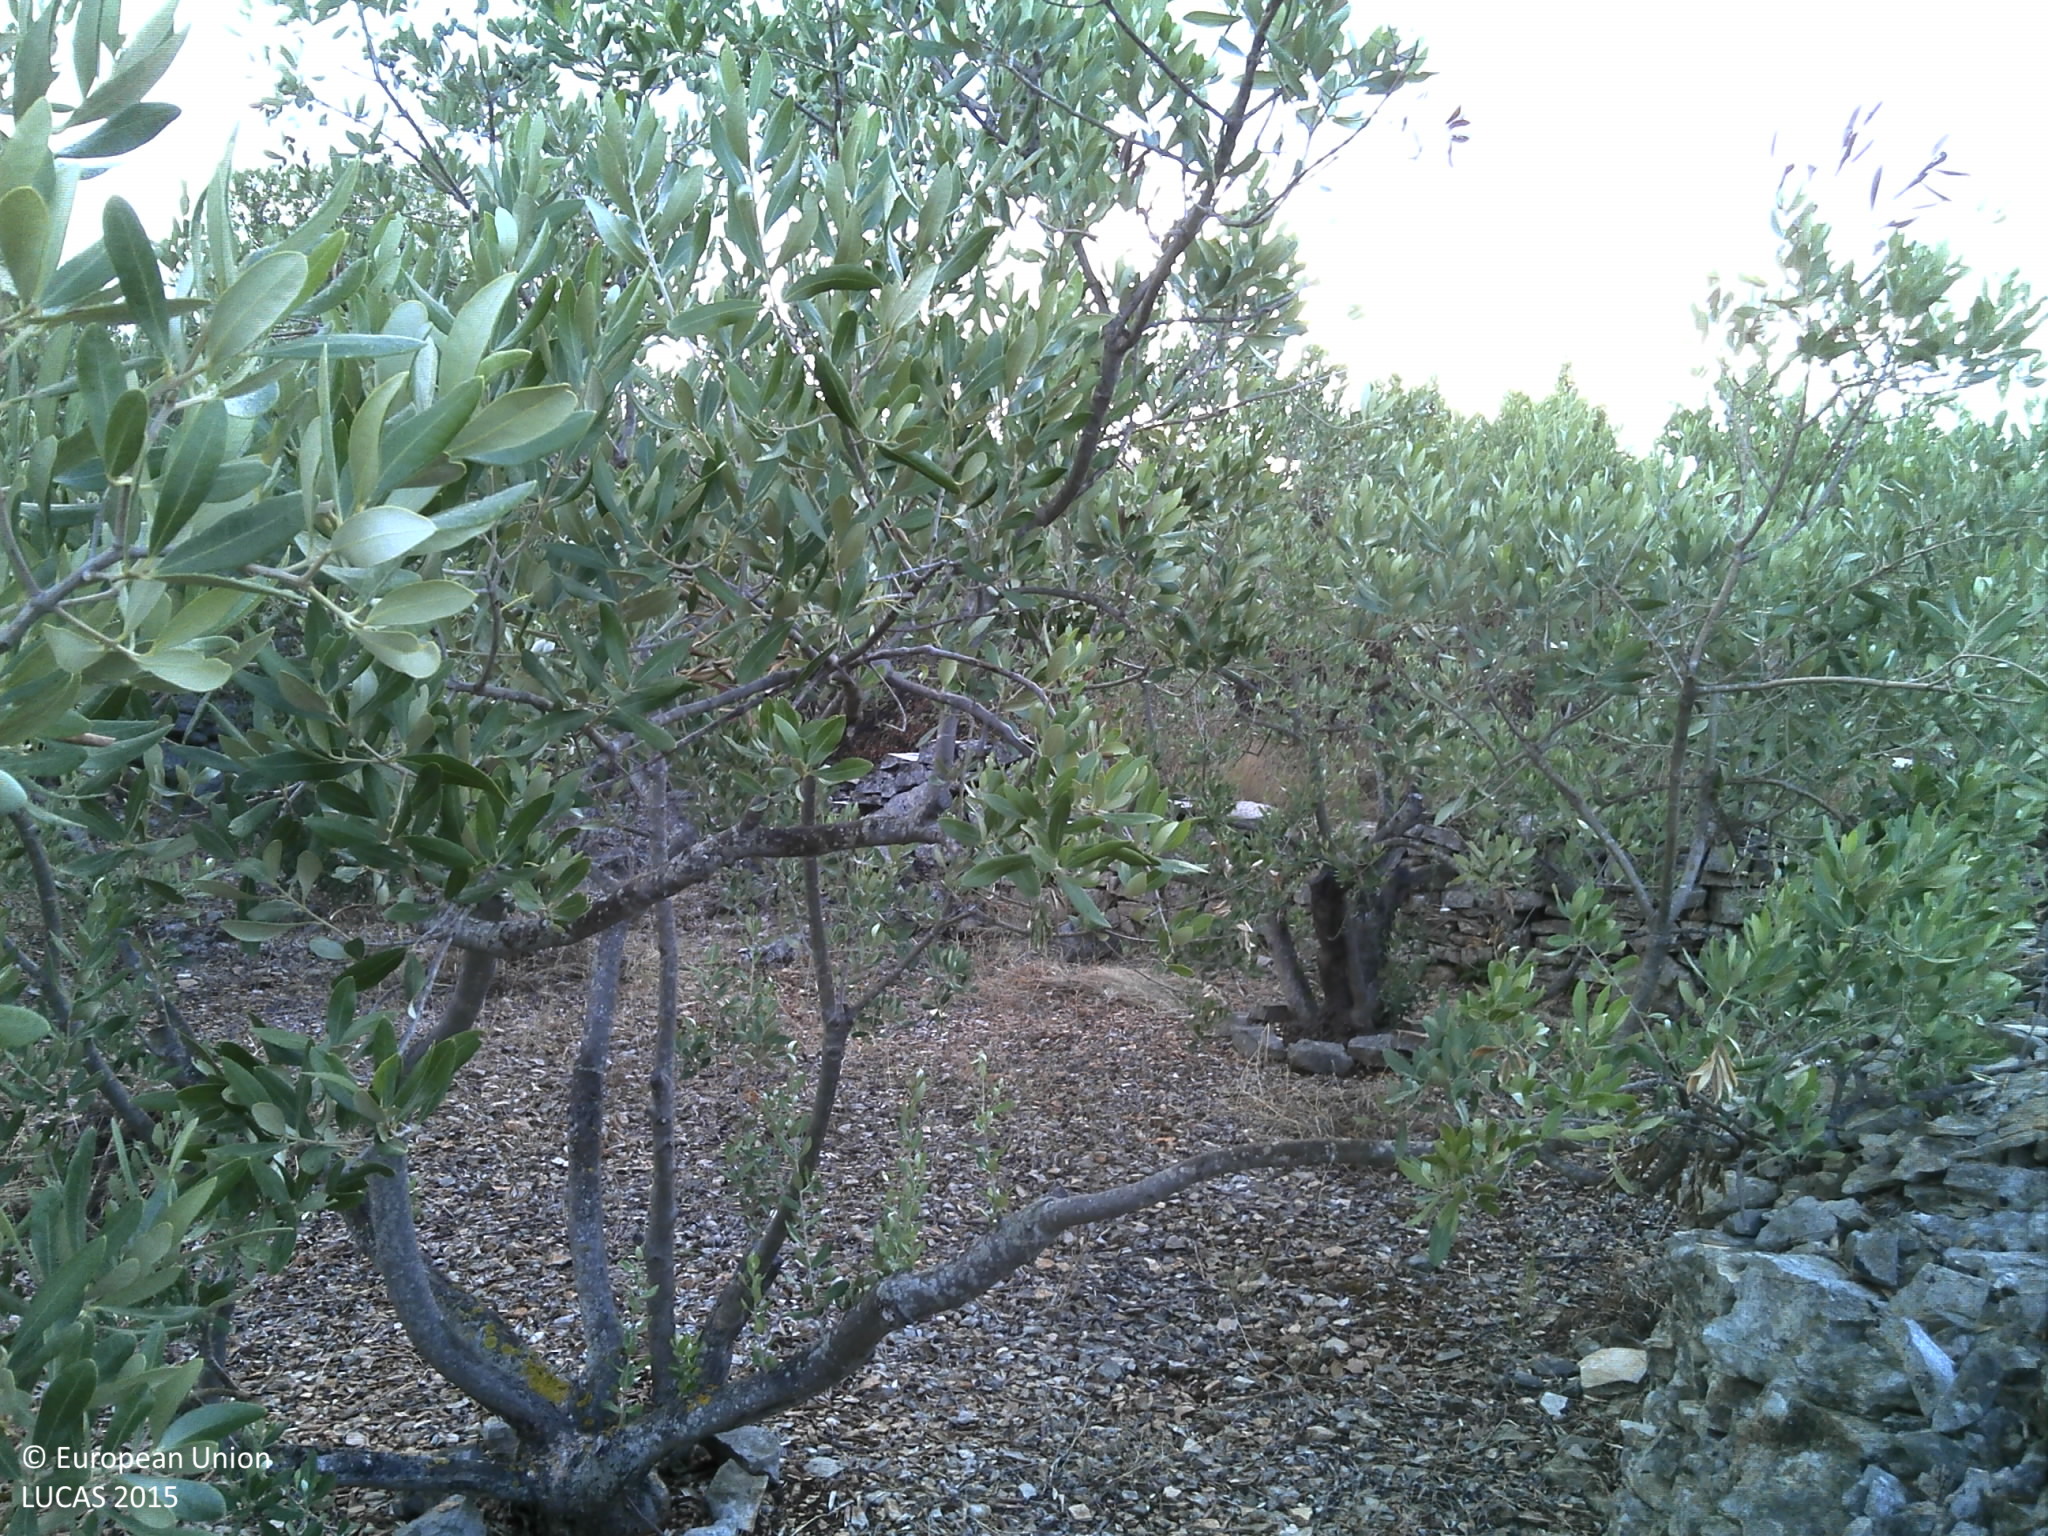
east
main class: Cropland
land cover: Olive groves
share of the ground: 50 - 75 %
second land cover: Other bare soil
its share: > 75 %
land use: Agriculture (excluding fallow land and kitchen gardens)
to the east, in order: Olive groves; Other bare soil; Dry stone walls; Olive groves; Dry stone walls; Paved roads, cycling and walking lanes; Dry stone walls; Olive groves; Dry stone walls; Shrubland with sparse tree cover; Dry stone walls; Shrubland with sparse tree cover; Dry stone walls; Olive groves; Dry stone walls; Shrubland with sparse tree cover; Pine dominated coniferous woodland
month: August
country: HR
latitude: 43.4008
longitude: 16.2749
